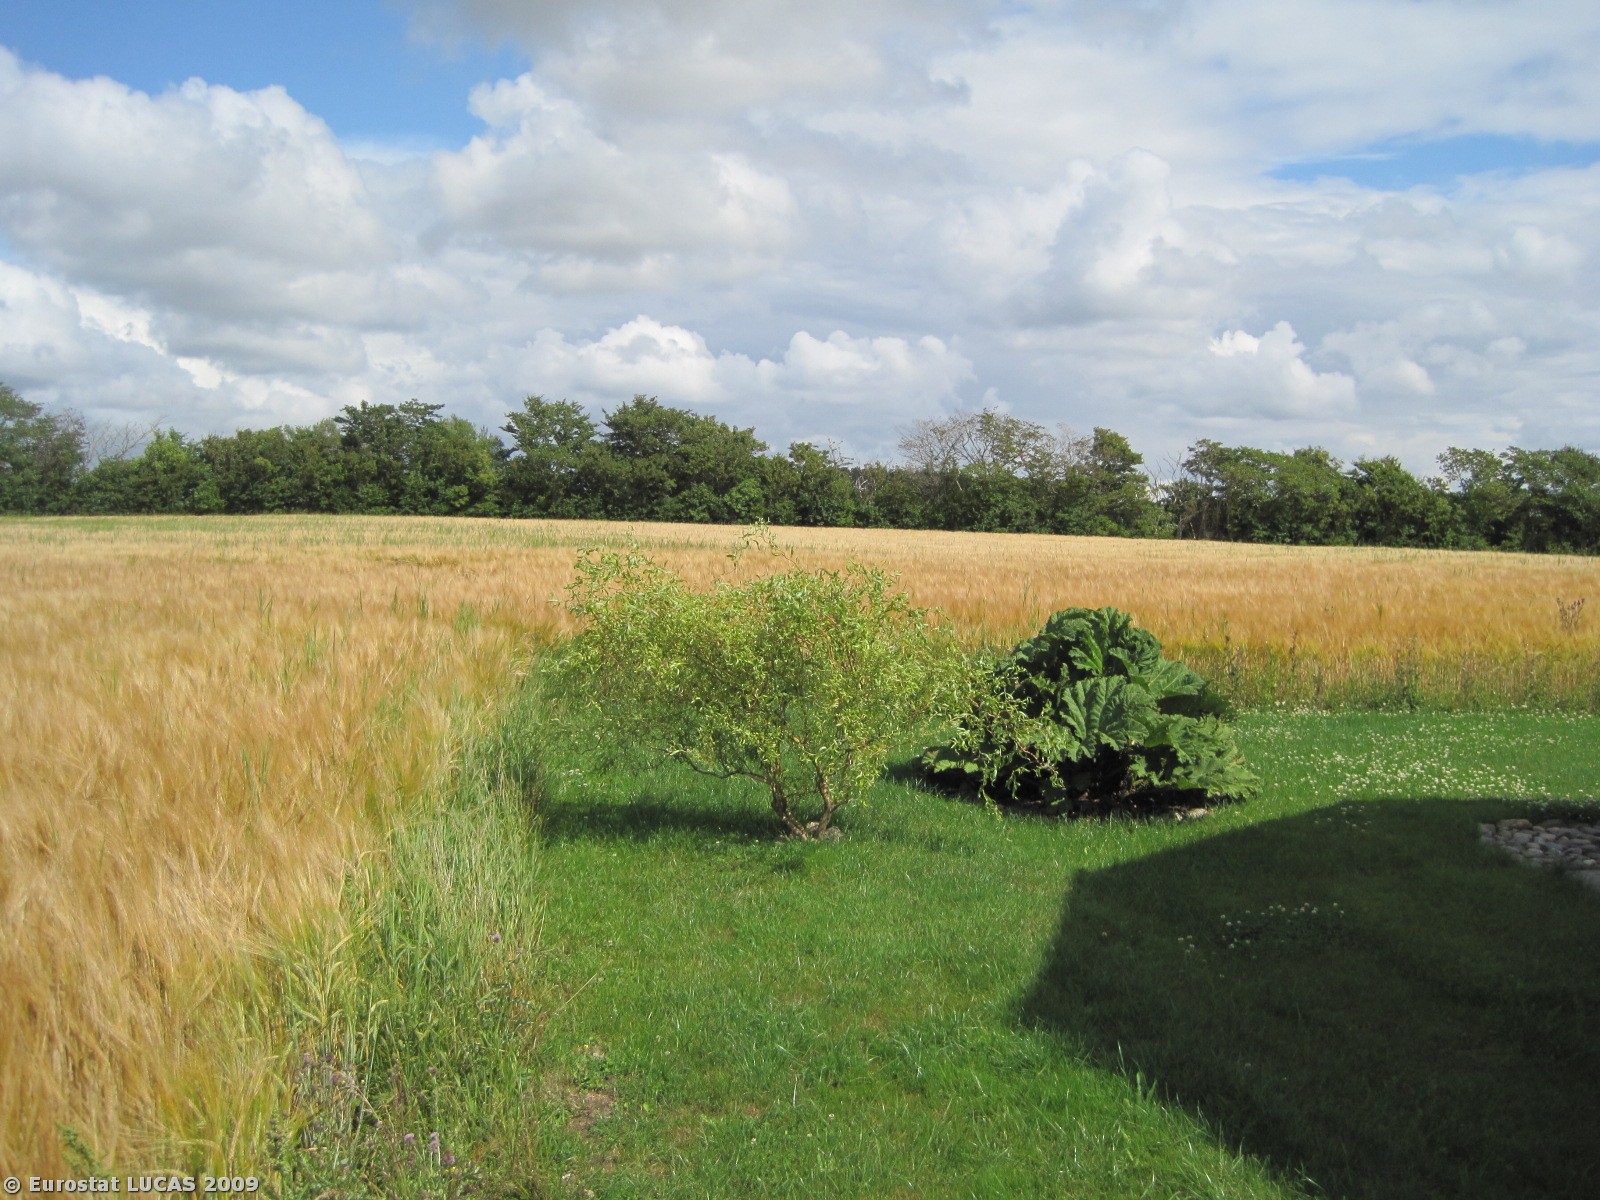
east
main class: Cropland
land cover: Barley
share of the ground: > 75 %
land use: Agriculture (excluding fallow land and kitchen gardens)
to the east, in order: Barley; Broadleaved woodland; Common wheat; Broadleaved woodland; Grassland without tree/shrub cover; Artificial constructions in urban areas
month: July
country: DK
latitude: 56.9726
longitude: 8.7351
